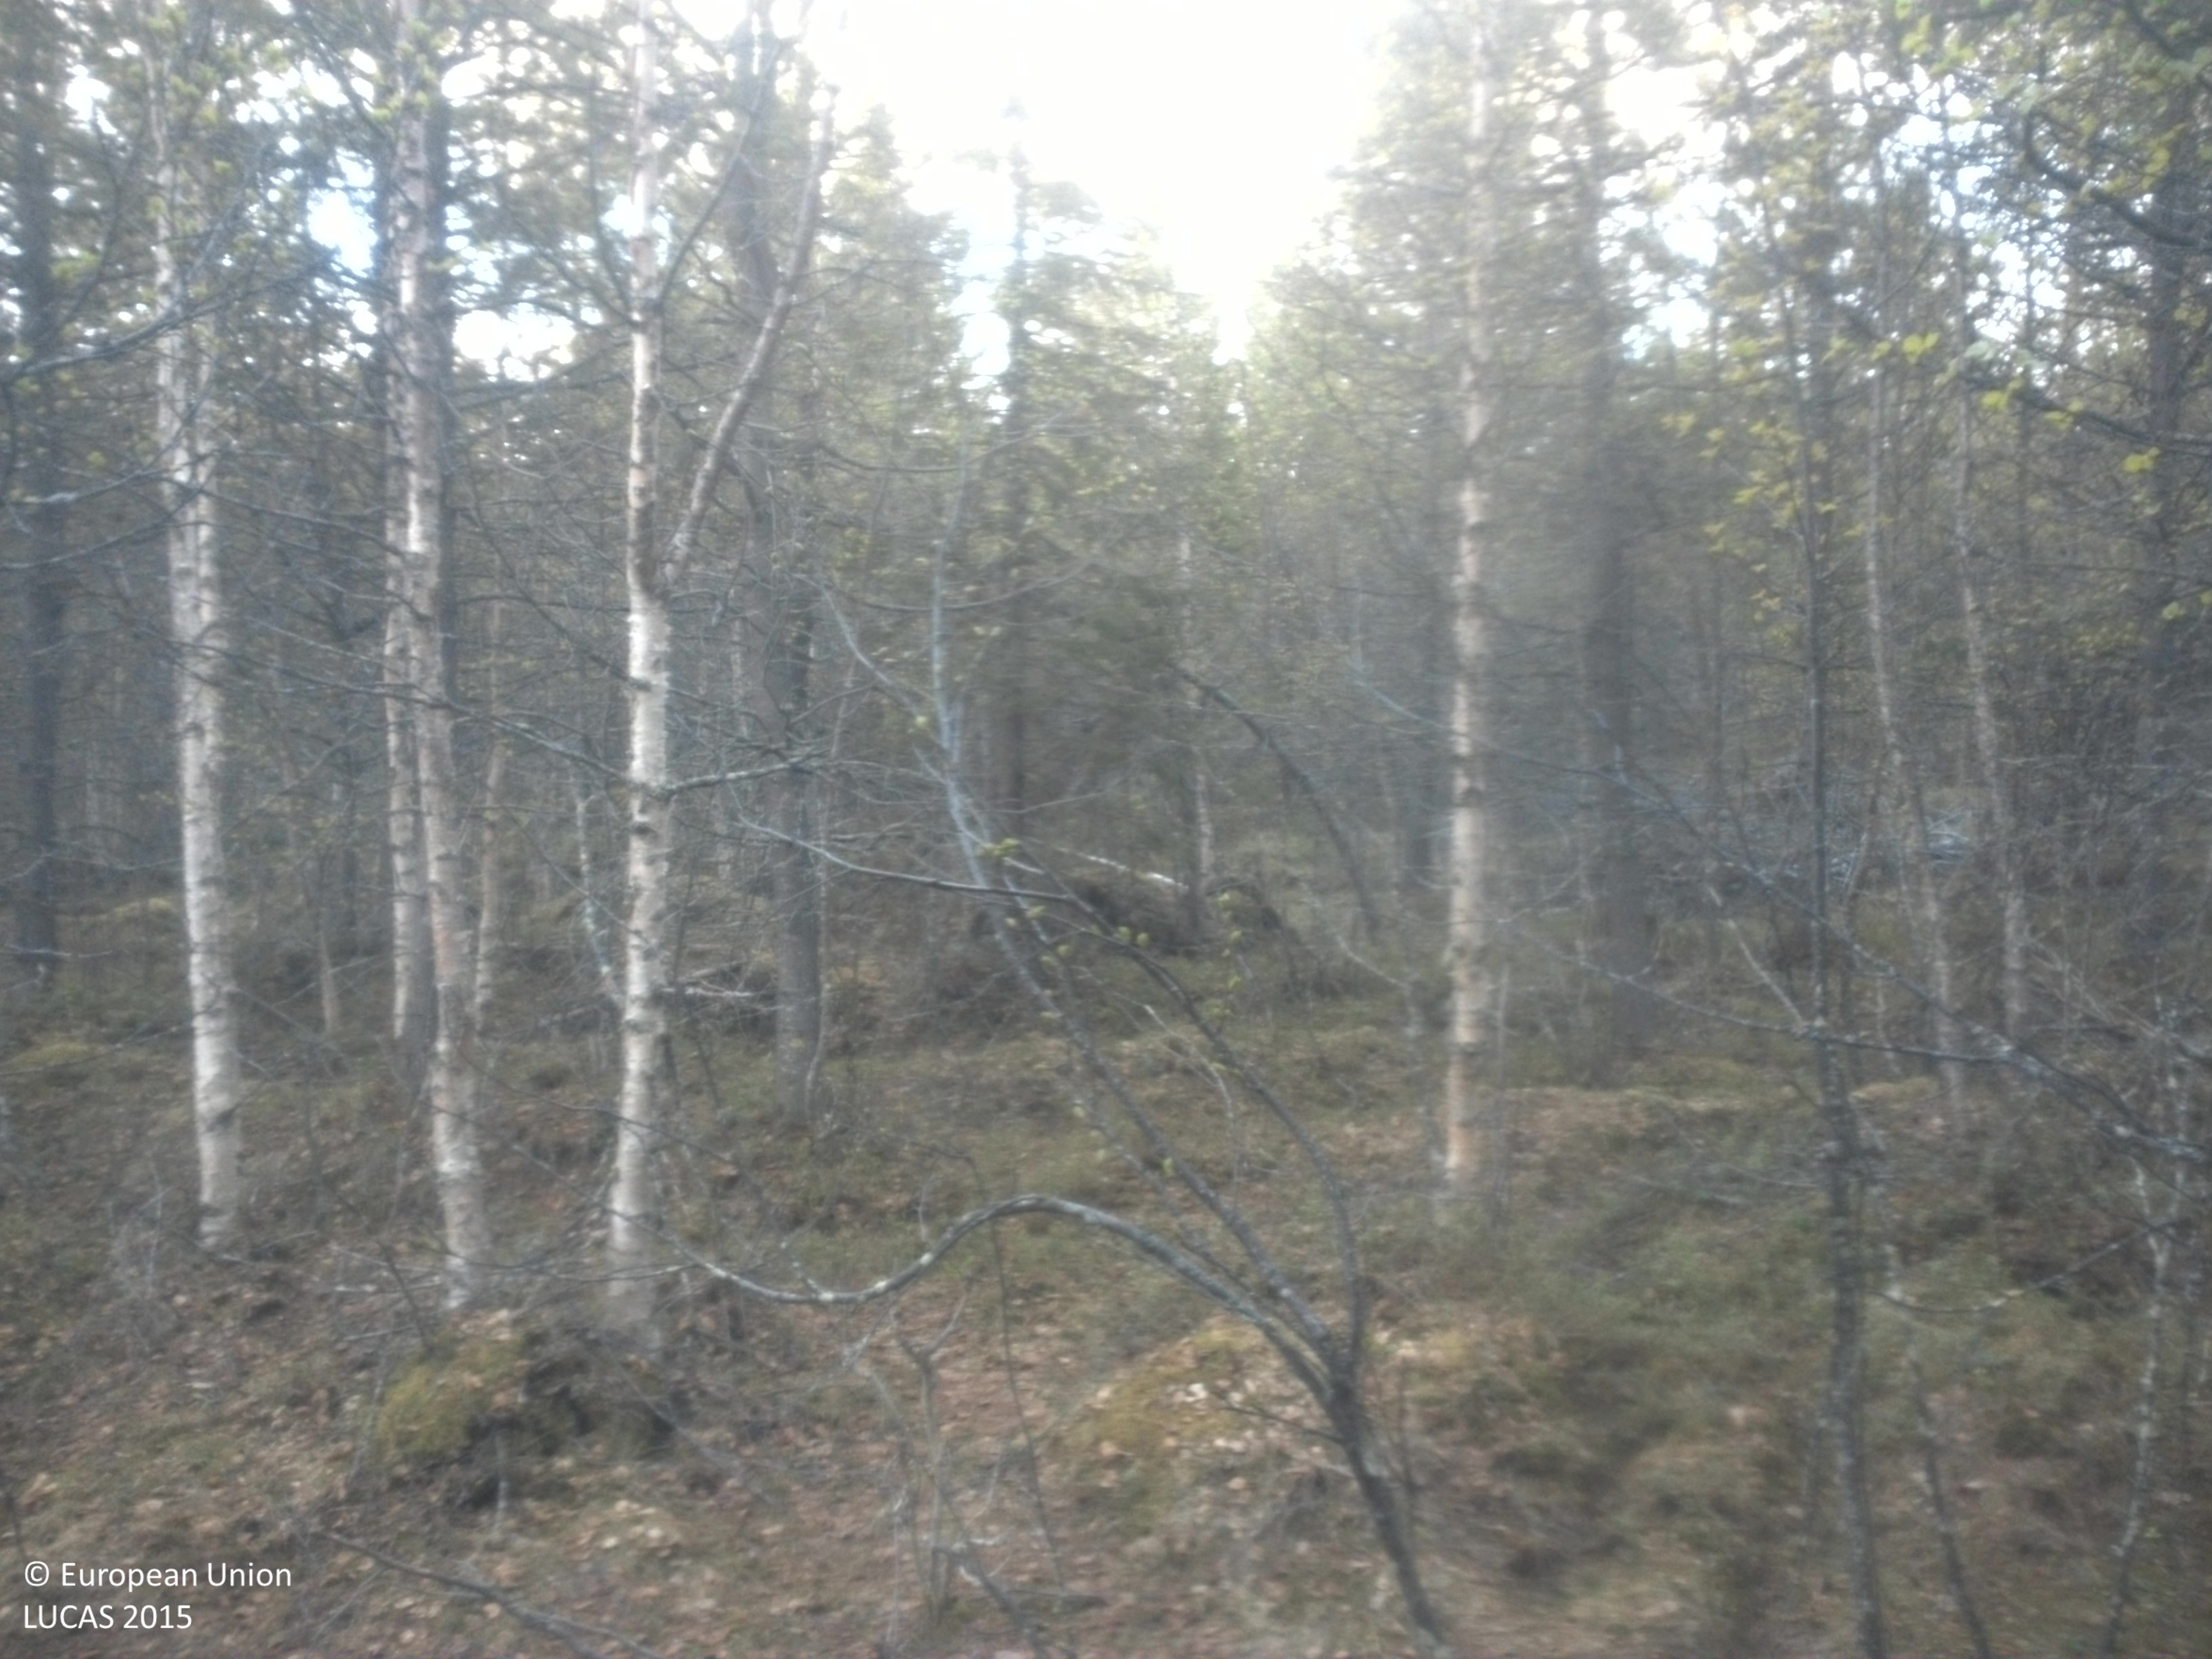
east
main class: Woodland
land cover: Pine dominated mixed woodland
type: exotic forest
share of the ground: 50 - 75 %
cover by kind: coniferous forest trees 45 %, herbaceous plants 20 %, broadleaved forest trees 15 %, lichens and mosses 10 %, shrubs 5 %, unconsolidated bare surface 5 %
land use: Forestry
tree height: > 5 m
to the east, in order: Pine dominated mixed woodland
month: June
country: SE
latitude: 64.4981
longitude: 17.7737
